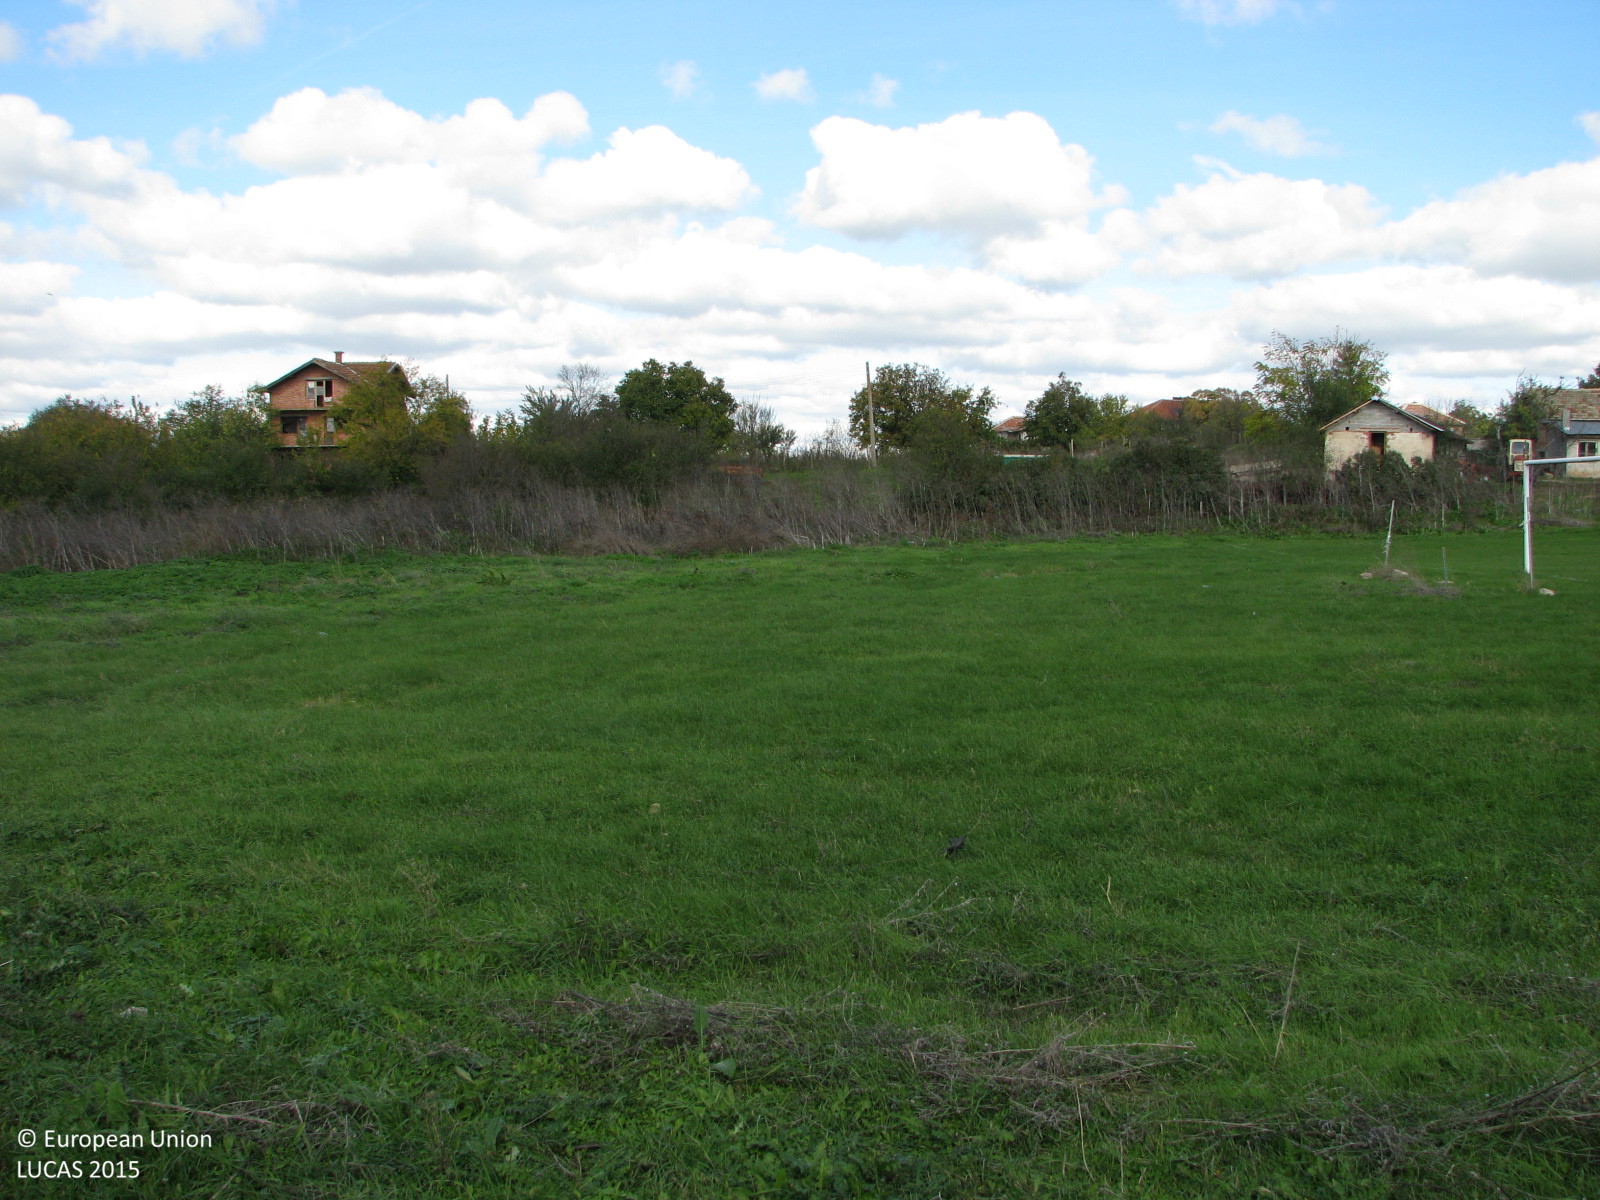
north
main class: Grassland
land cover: Grassland without tree/shrub cover
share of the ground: > 75 %
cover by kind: herbaceous plants 100 %
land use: Sport
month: October
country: BG
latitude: 42.3358
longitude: 26.7354
